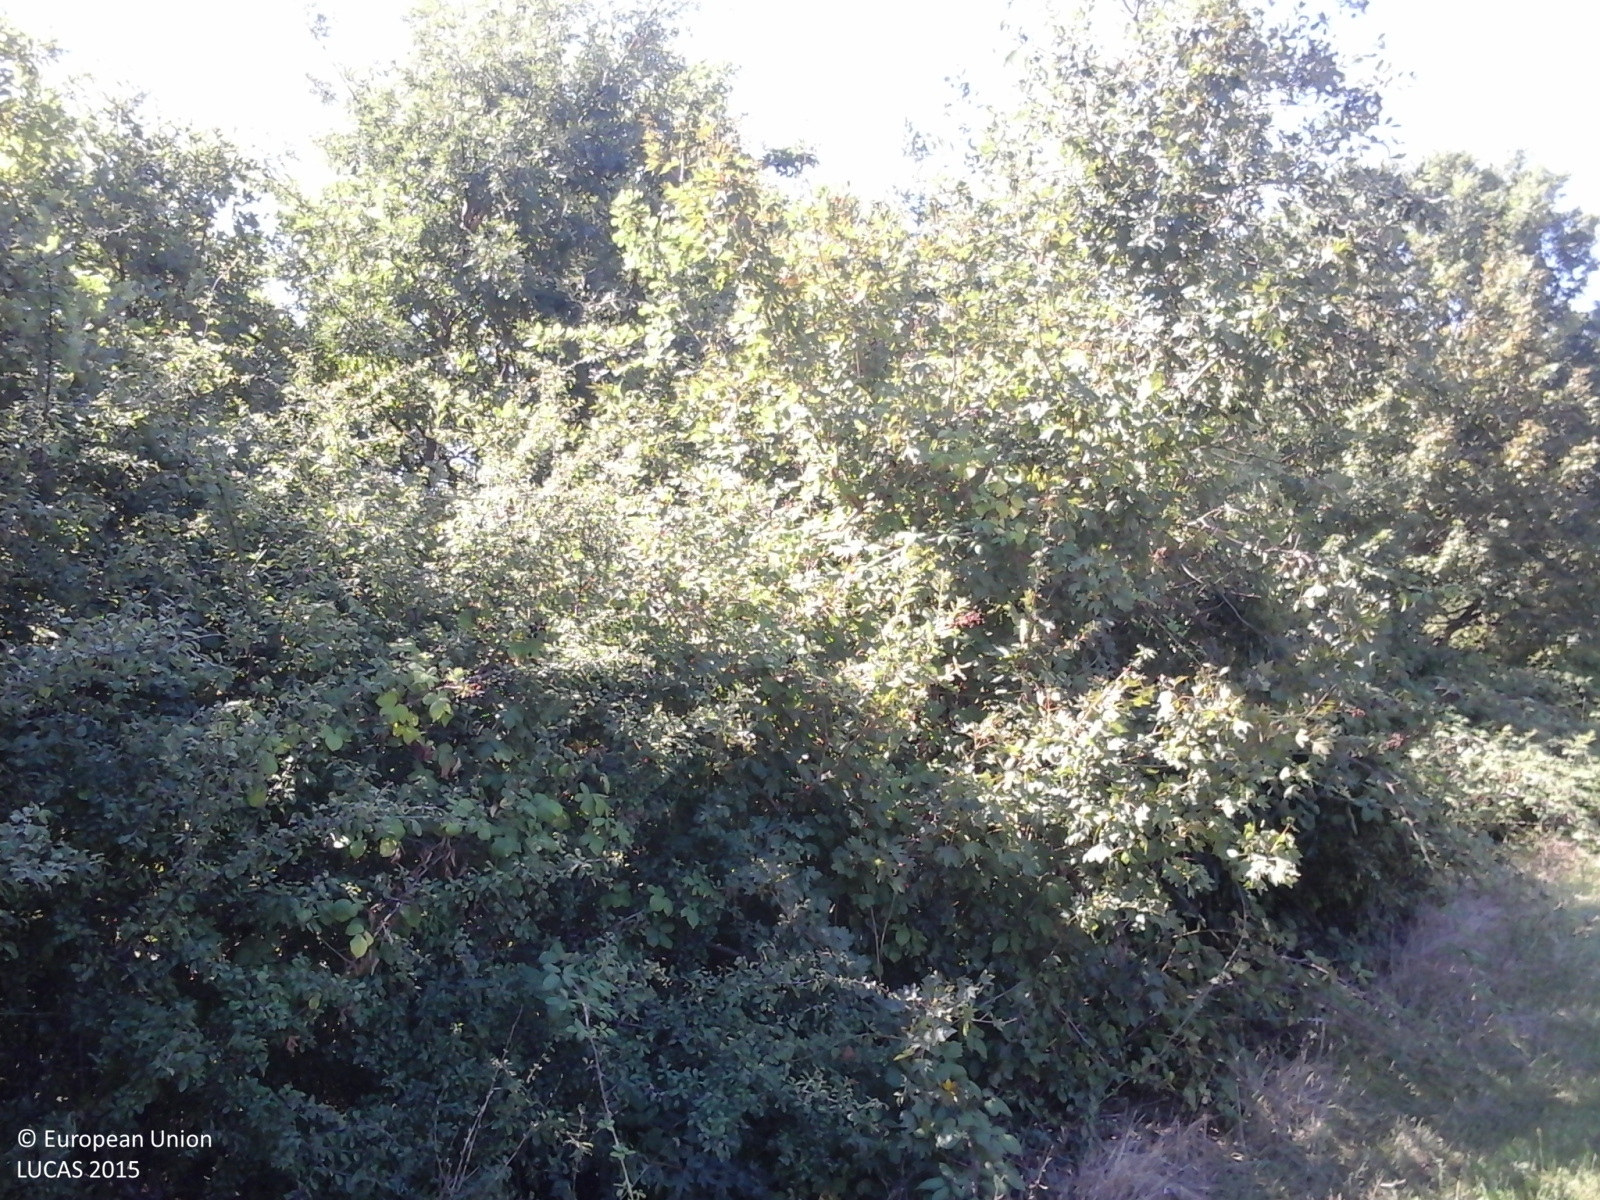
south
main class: Woodland
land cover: Broadleaved woodland
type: thermophilous deciduous forest
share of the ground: > 75 %
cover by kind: broadleaved forest trees 100 %
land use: Forestry
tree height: > 5 m
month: August
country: IT
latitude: 42.8987
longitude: 12.3076
